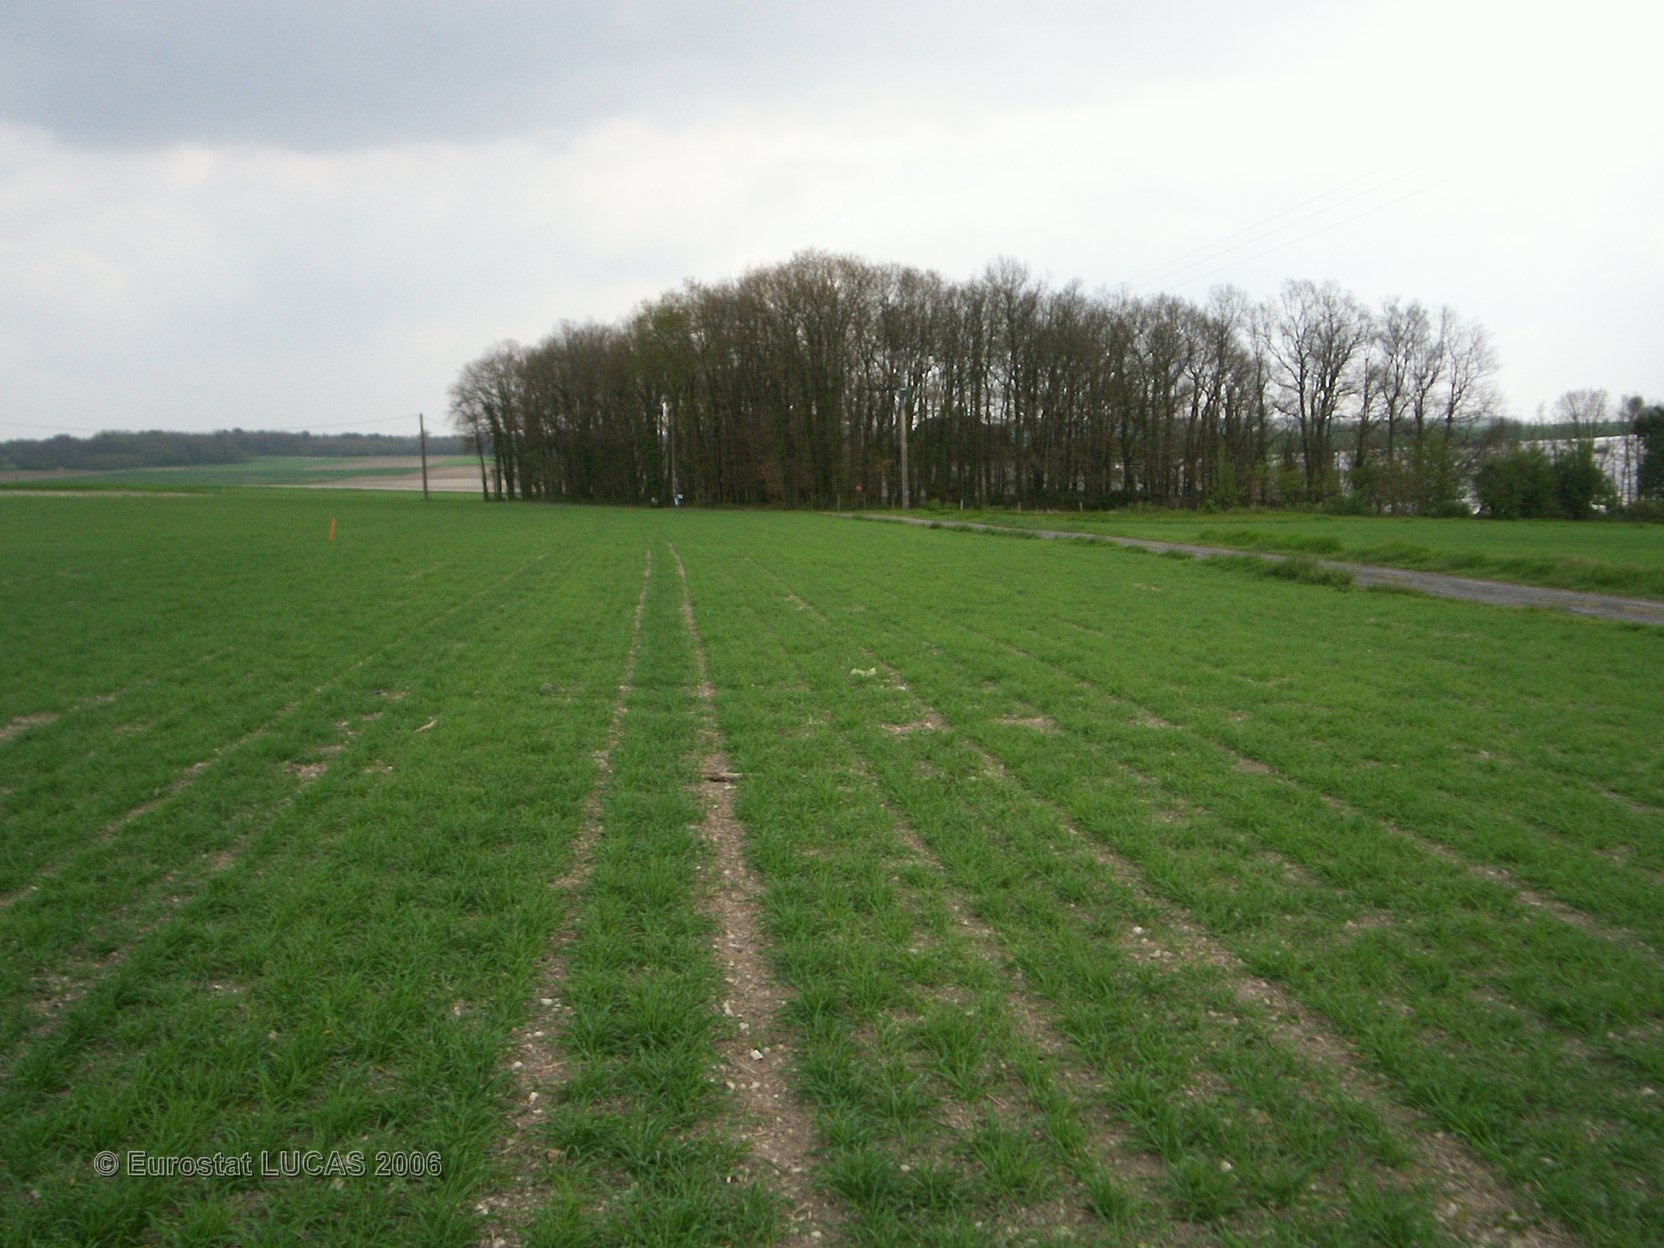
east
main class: Cropland
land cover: Barley
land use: Agriculture (excluding fallow land and kitchen gardens)
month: April
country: FR
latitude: 47.0900
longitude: 0.3227
